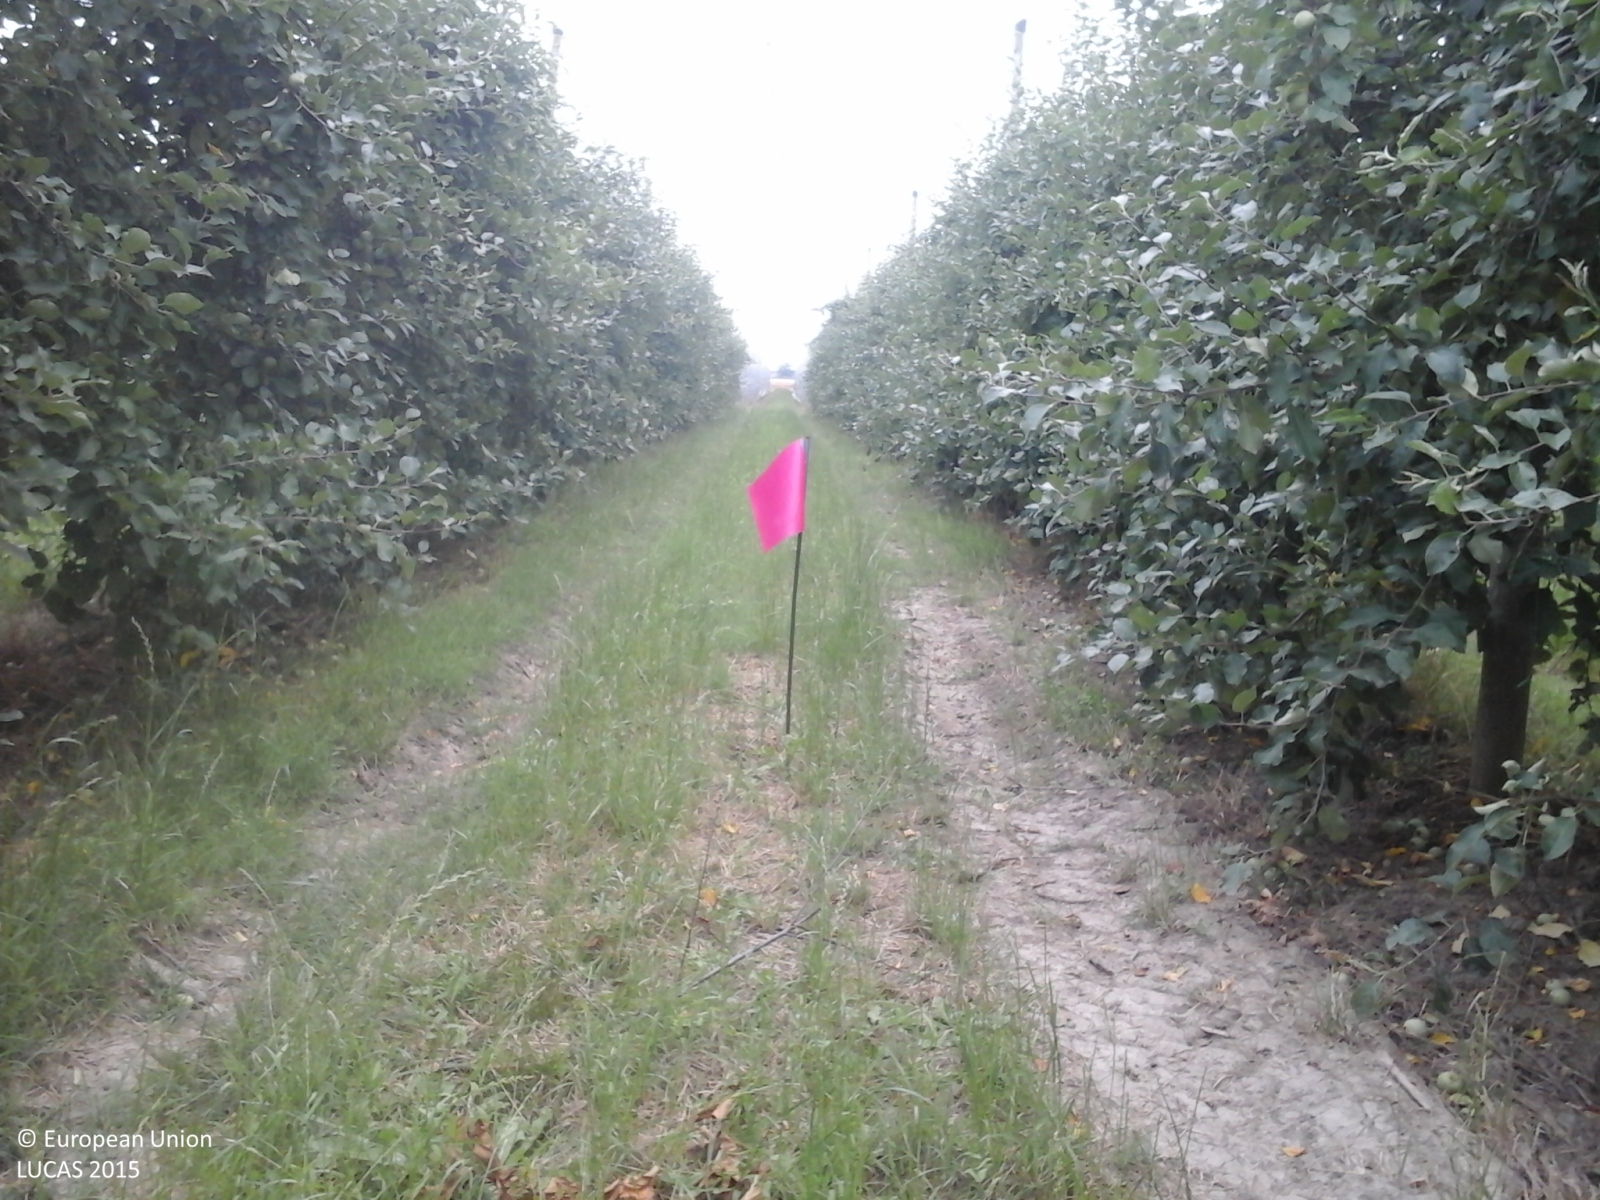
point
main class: Cropland
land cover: Apple fruit
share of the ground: > 75 %
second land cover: Grassland without tree/shrub cover
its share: > 75 %
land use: Agriculture (excluding fallow land and kitchen gardens)
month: June
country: IT
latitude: 44.7773
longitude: 11.1224
